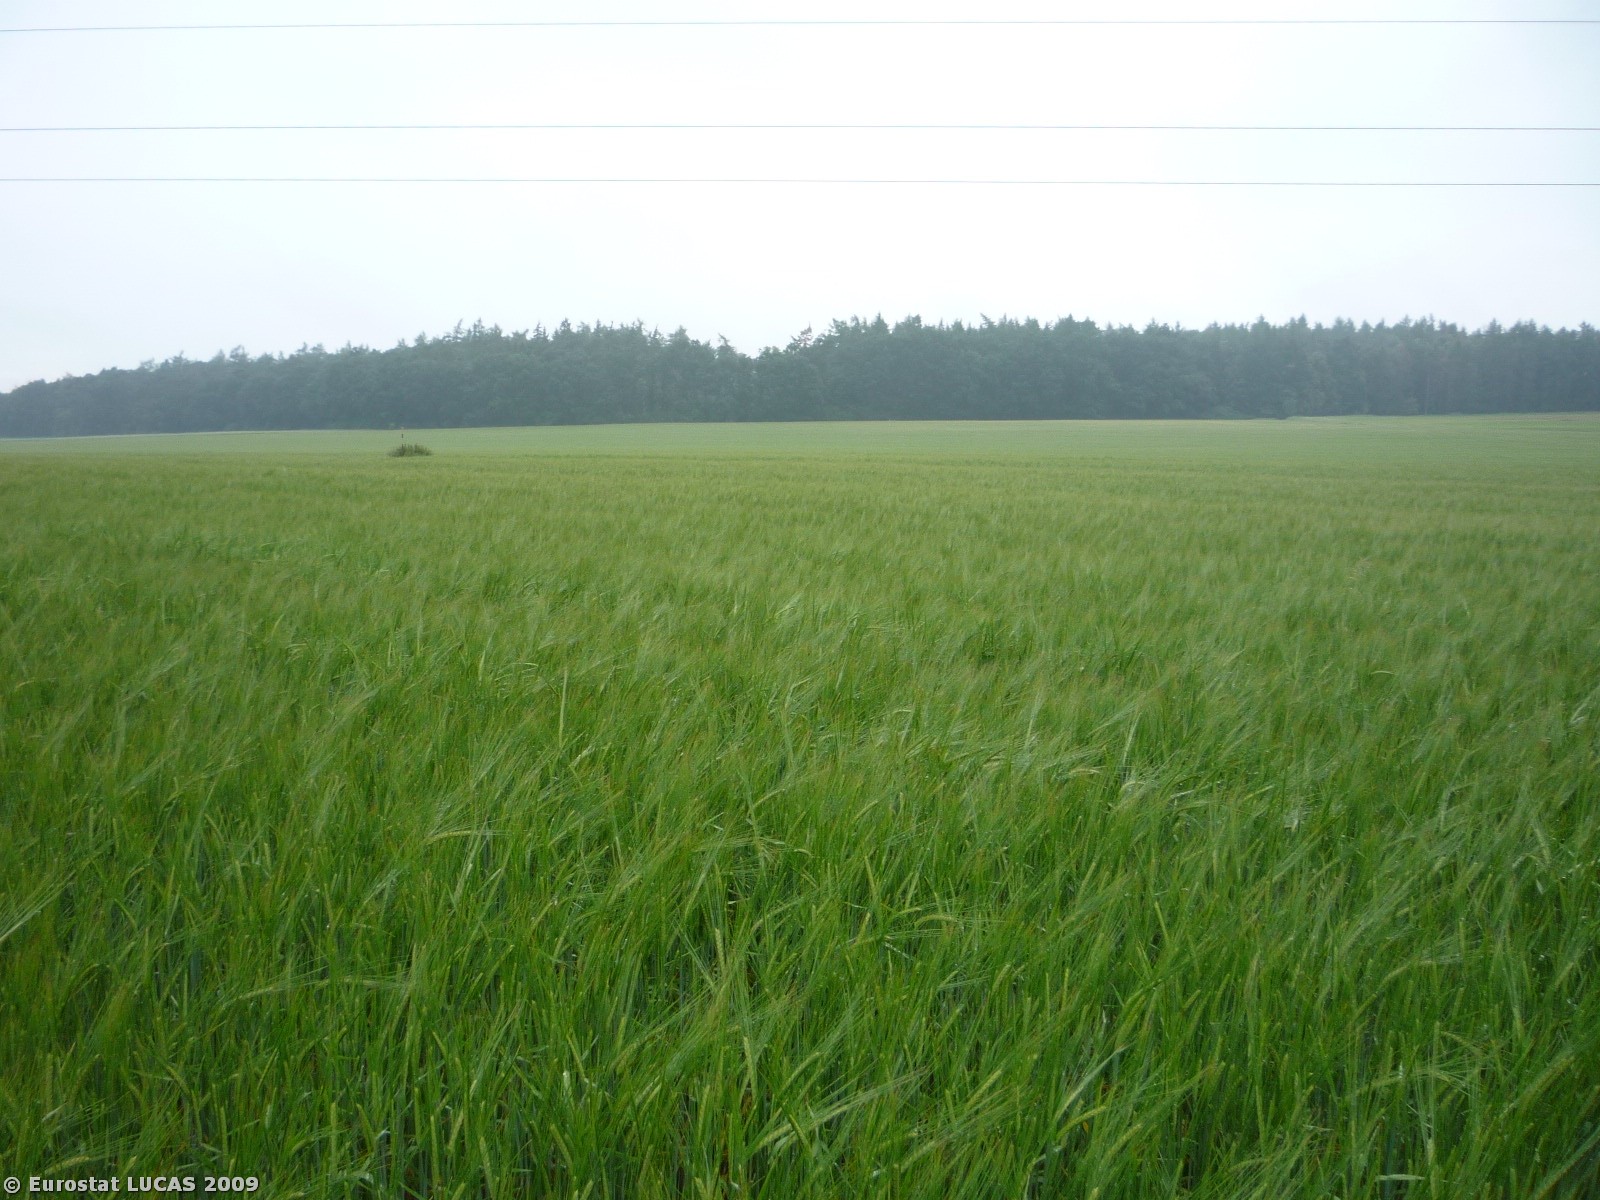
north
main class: Cropland
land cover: Barley
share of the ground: > 75 %
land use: Agriculture (excluding fallow land and kitchen gardens)
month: June
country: CZ
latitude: 50.1145
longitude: 14.9111
